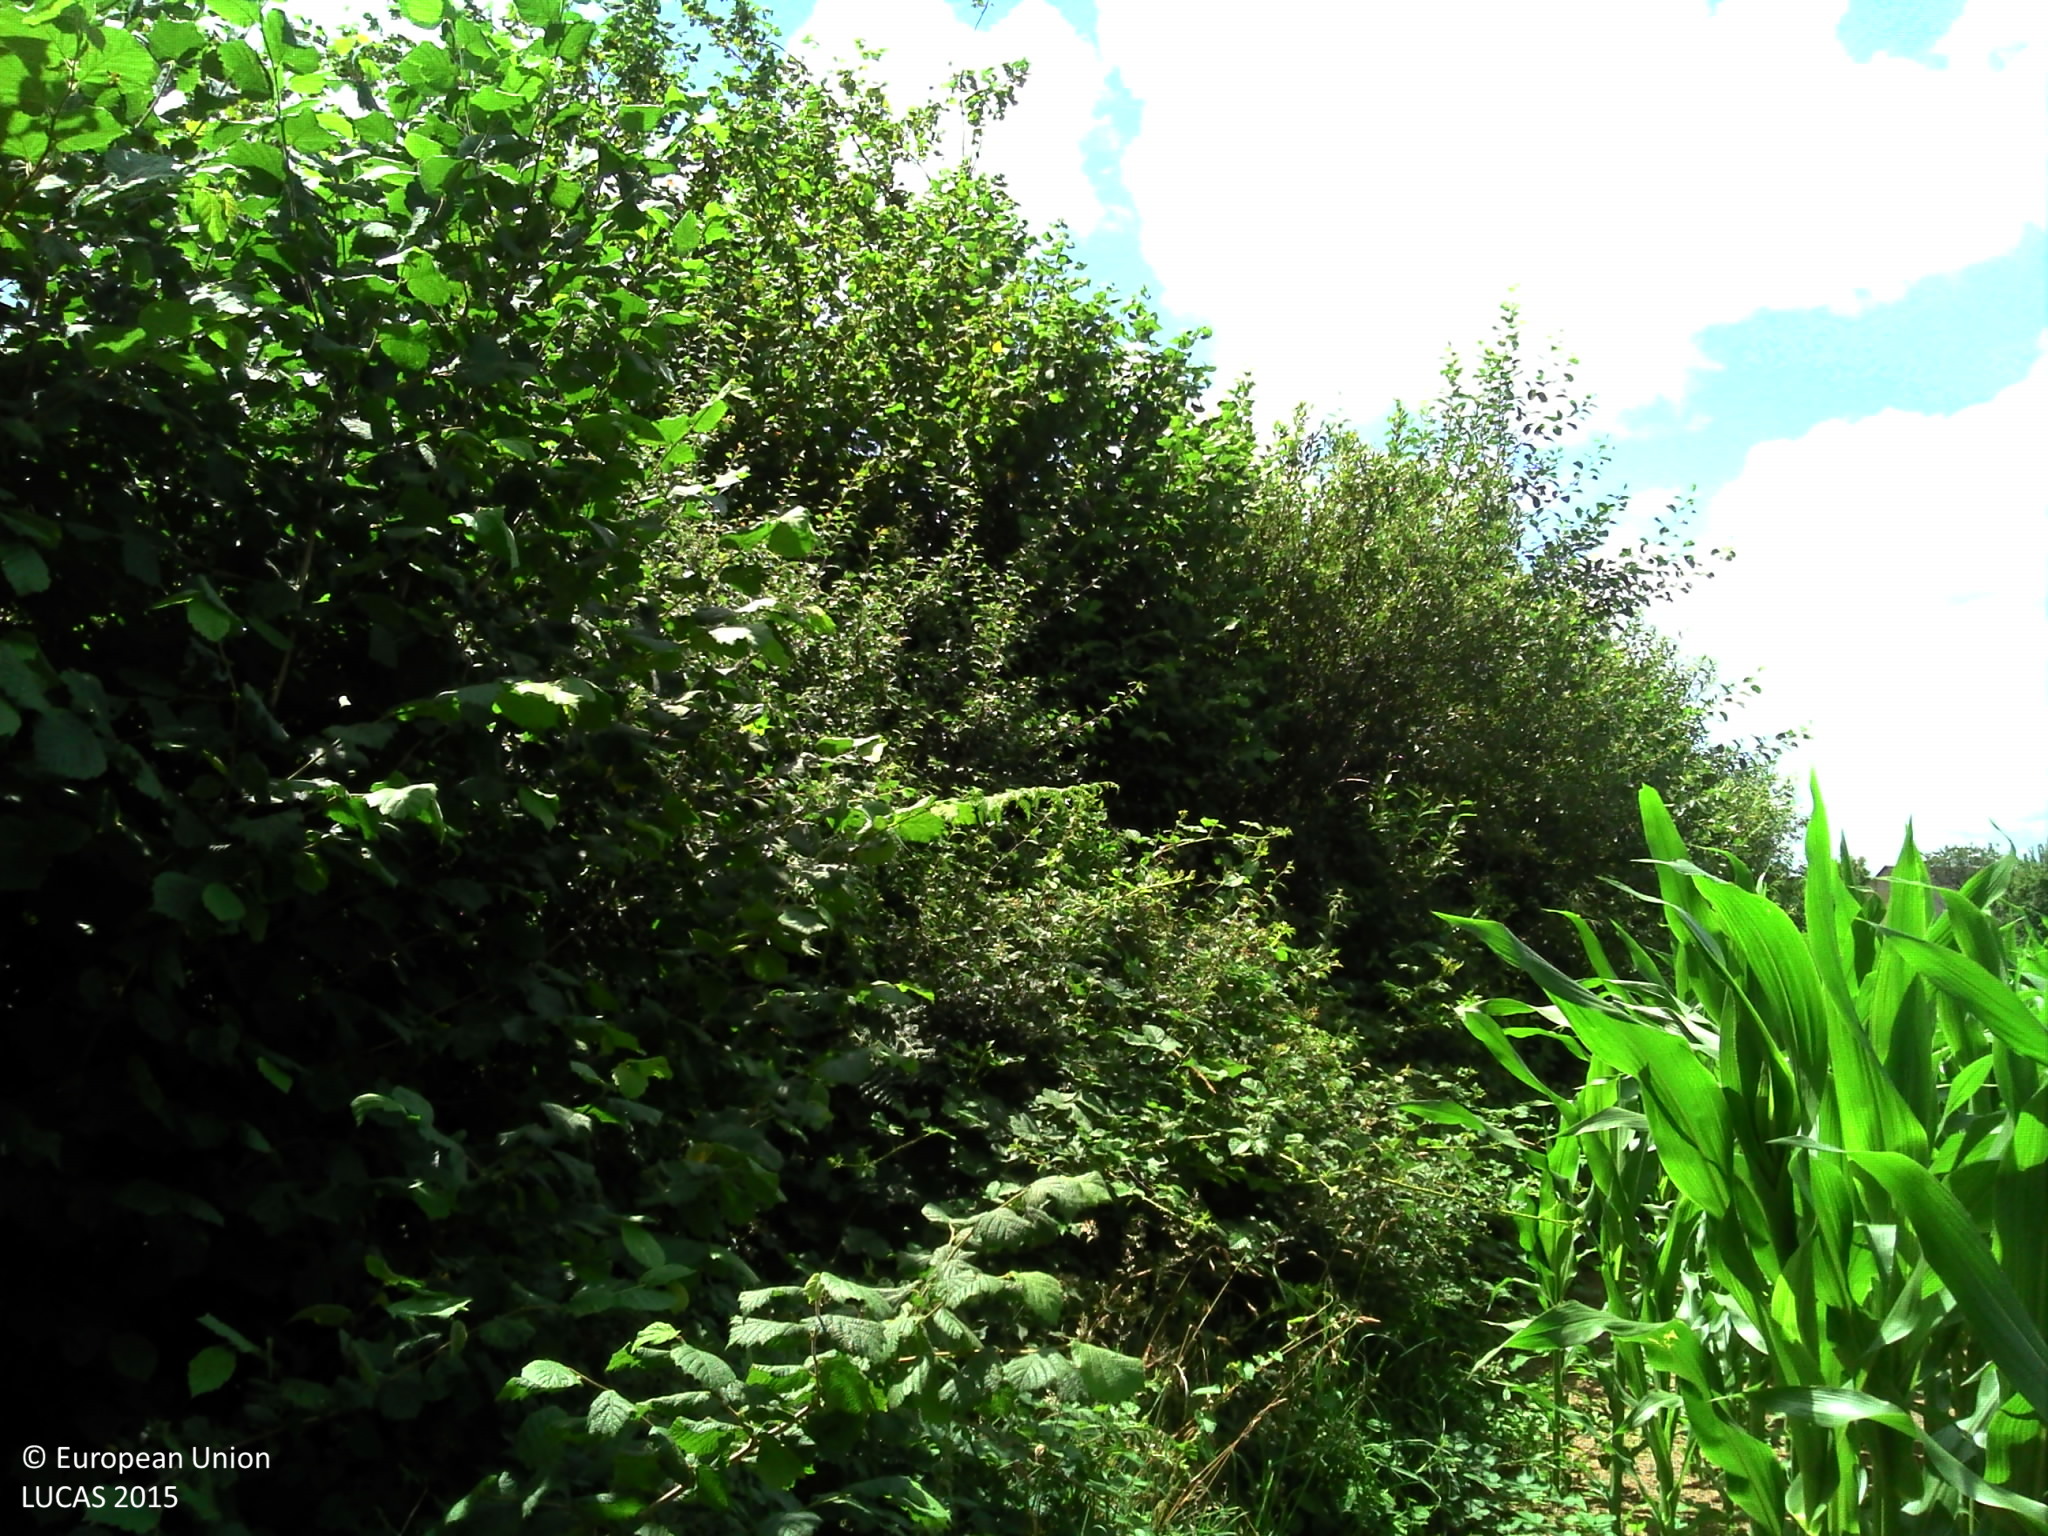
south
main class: Cropland
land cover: Maize
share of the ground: > 75 %
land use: Agriculture (excluding fallow land and kitchen gardens)
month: July
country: FR
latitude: 48.5467
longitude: -0.2049
